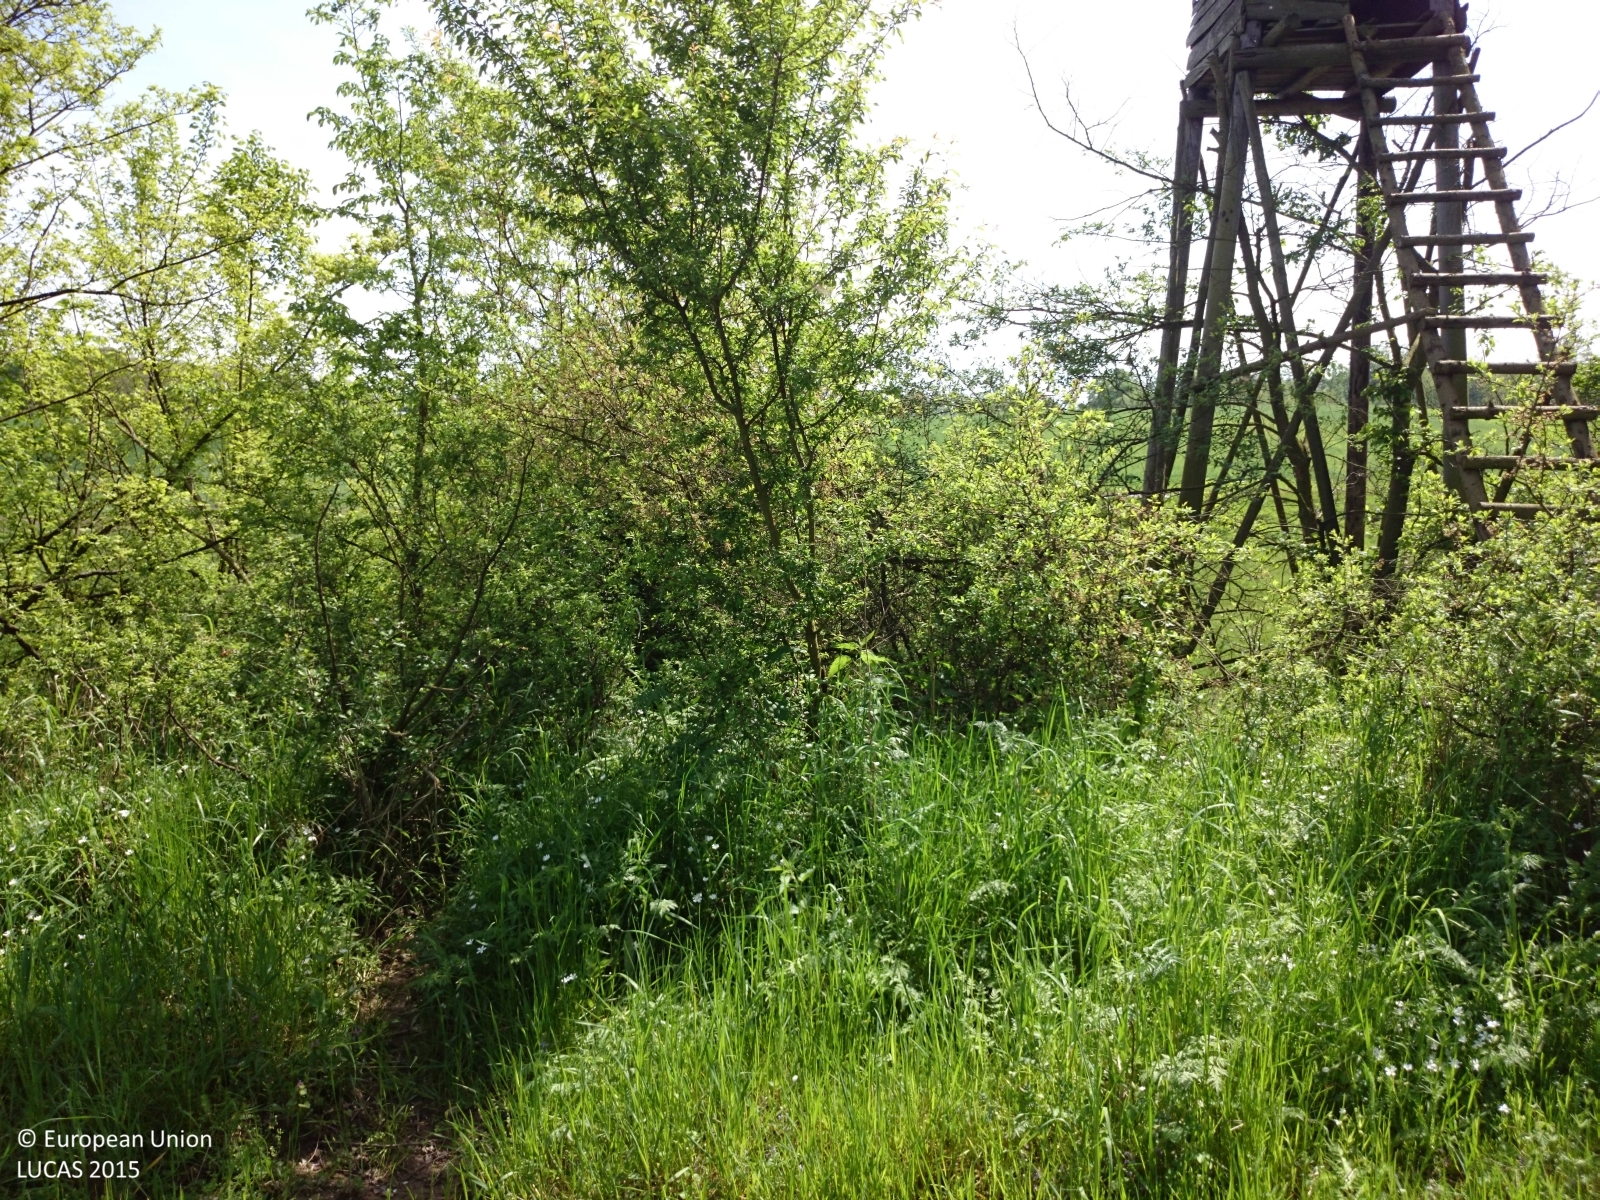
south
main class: Cropland
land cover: Barley
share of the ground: > 75 %
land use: Agriculture (excluding fallow land and kitchen gardens)
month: May
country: PL
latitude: 52.4810
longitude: 16.2940
